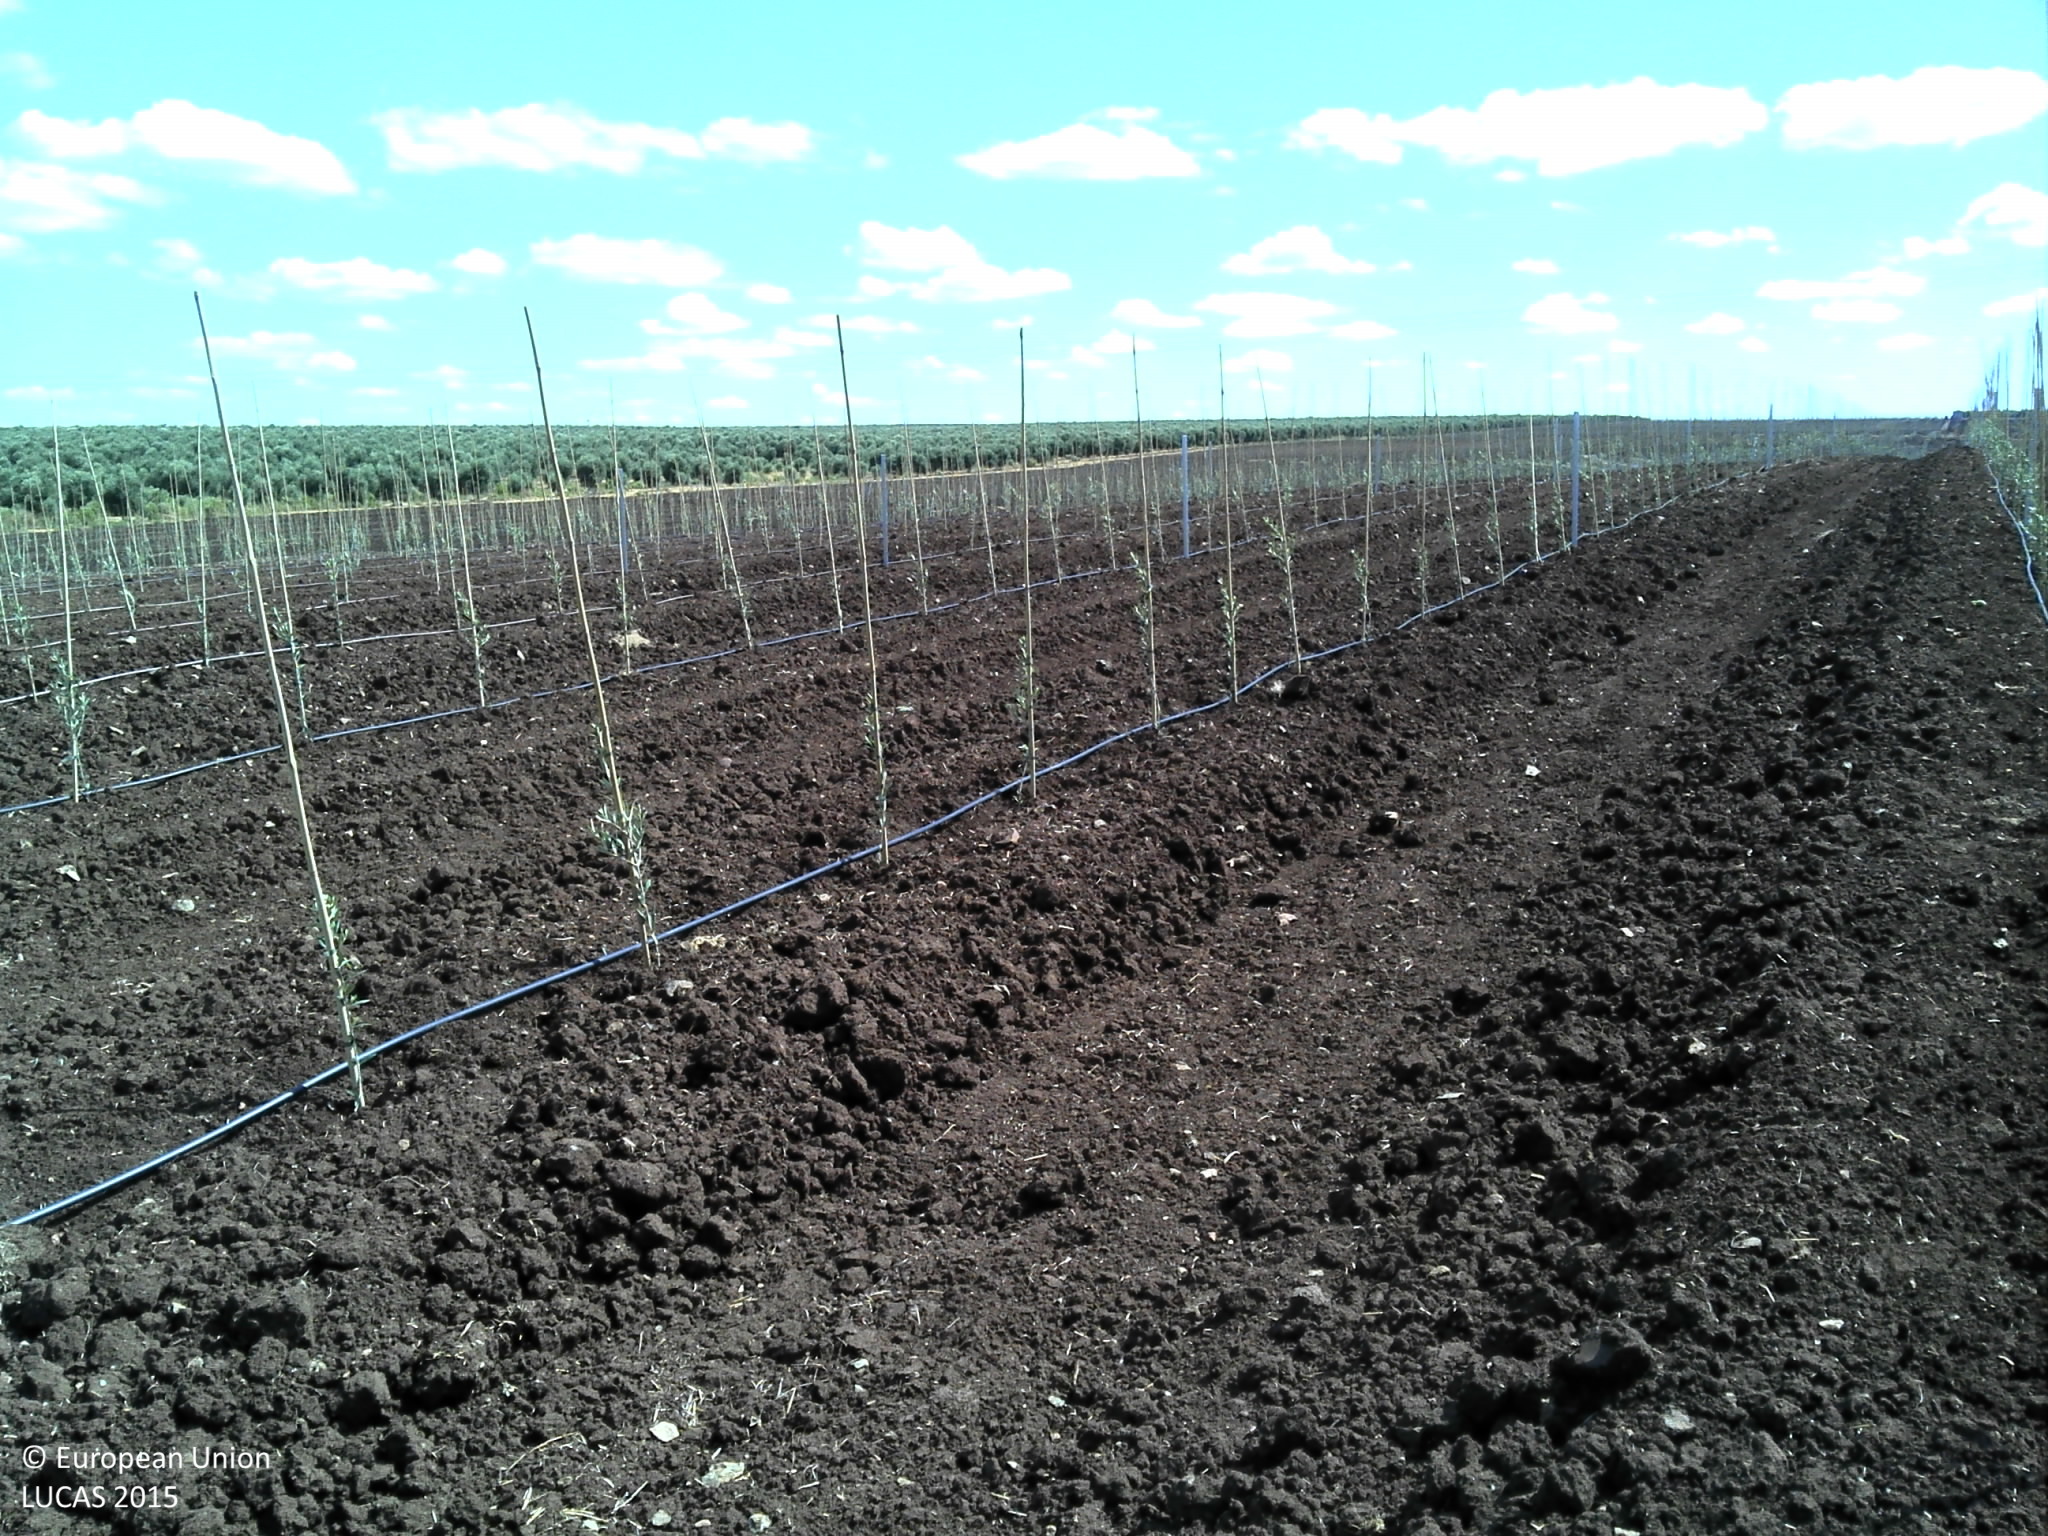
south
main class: Cropland
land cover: Olive groves
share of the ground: 10 - 25 %
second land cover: Other bare soil
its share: > 75 %
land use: Agriculture (excluding fallow land and kitchen gardens)
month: July
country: PT
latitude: 37.9993
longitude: -7.6858
